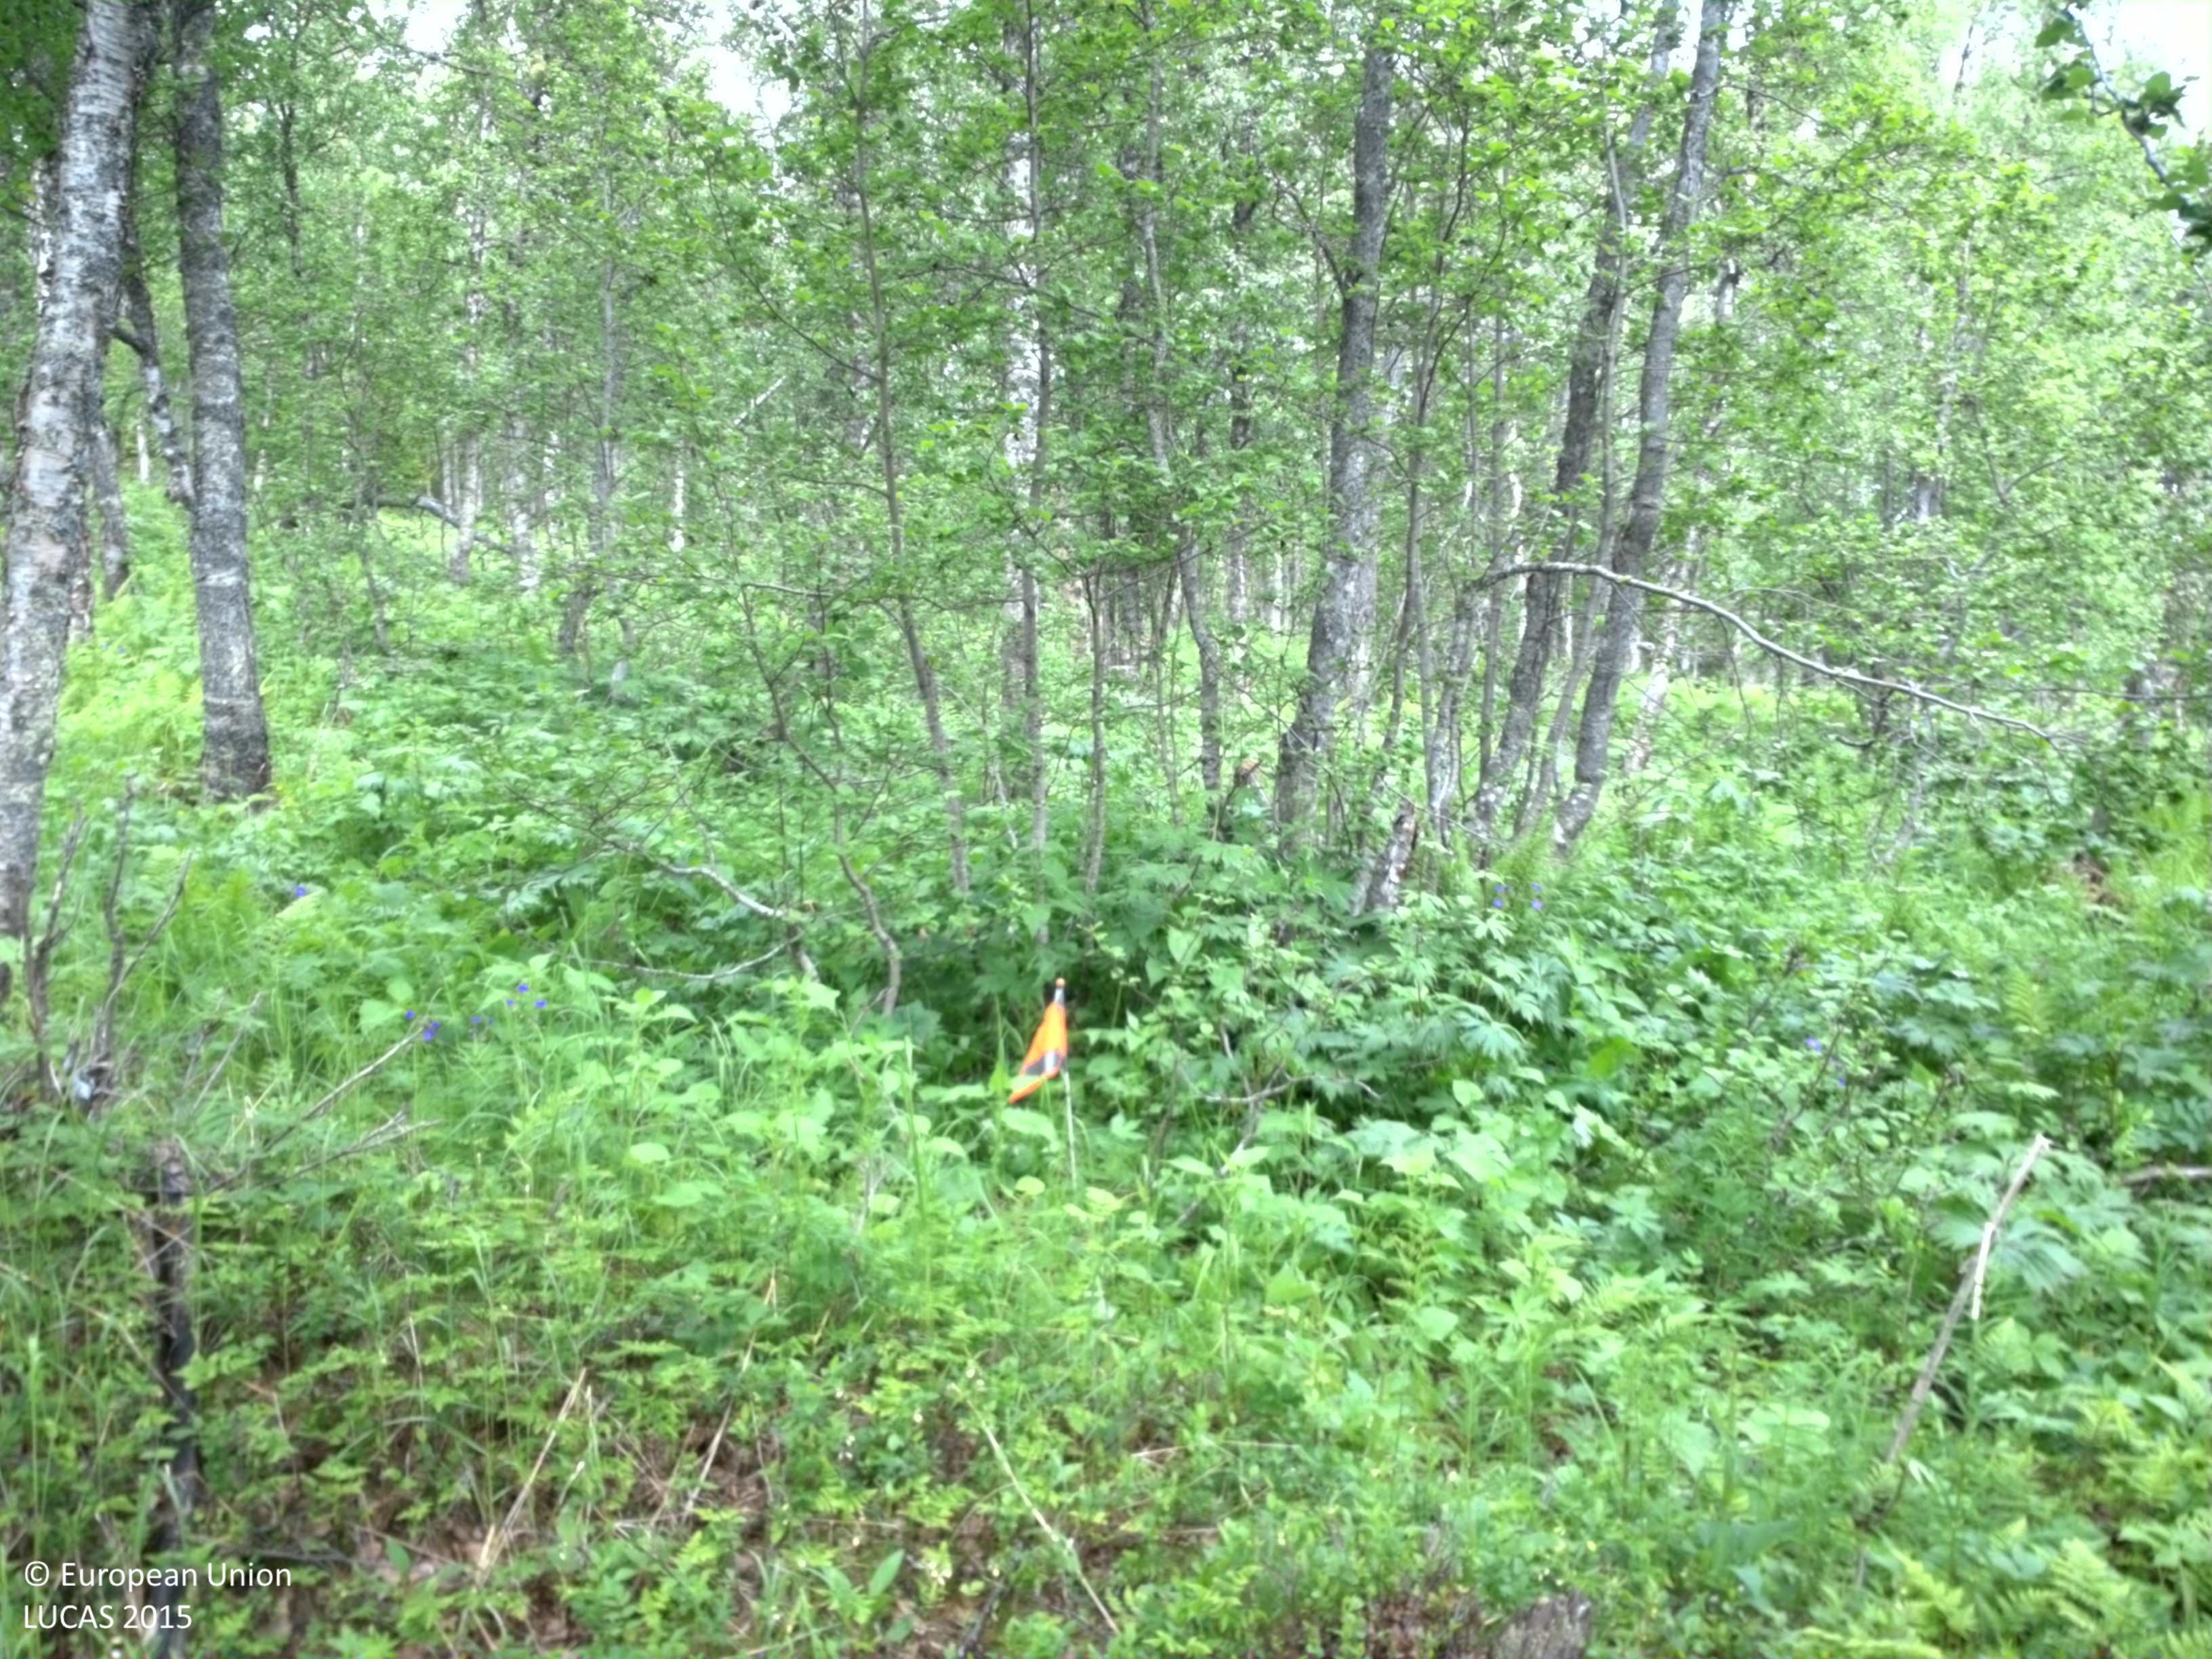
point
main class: Woodland
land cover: Broadleaved woodland
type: non-riverine alder, birch or aspen forest
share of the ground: 25 - 50 %
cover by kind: herbaceous plants 55 %, broadleaved forest trees 40 %, shrubs 5 %
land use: Semi-natural and natural areas not in use
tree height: > 5 m
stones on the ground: < 10 %
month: July
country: SE
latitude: 65.6735
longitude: 15.1214
